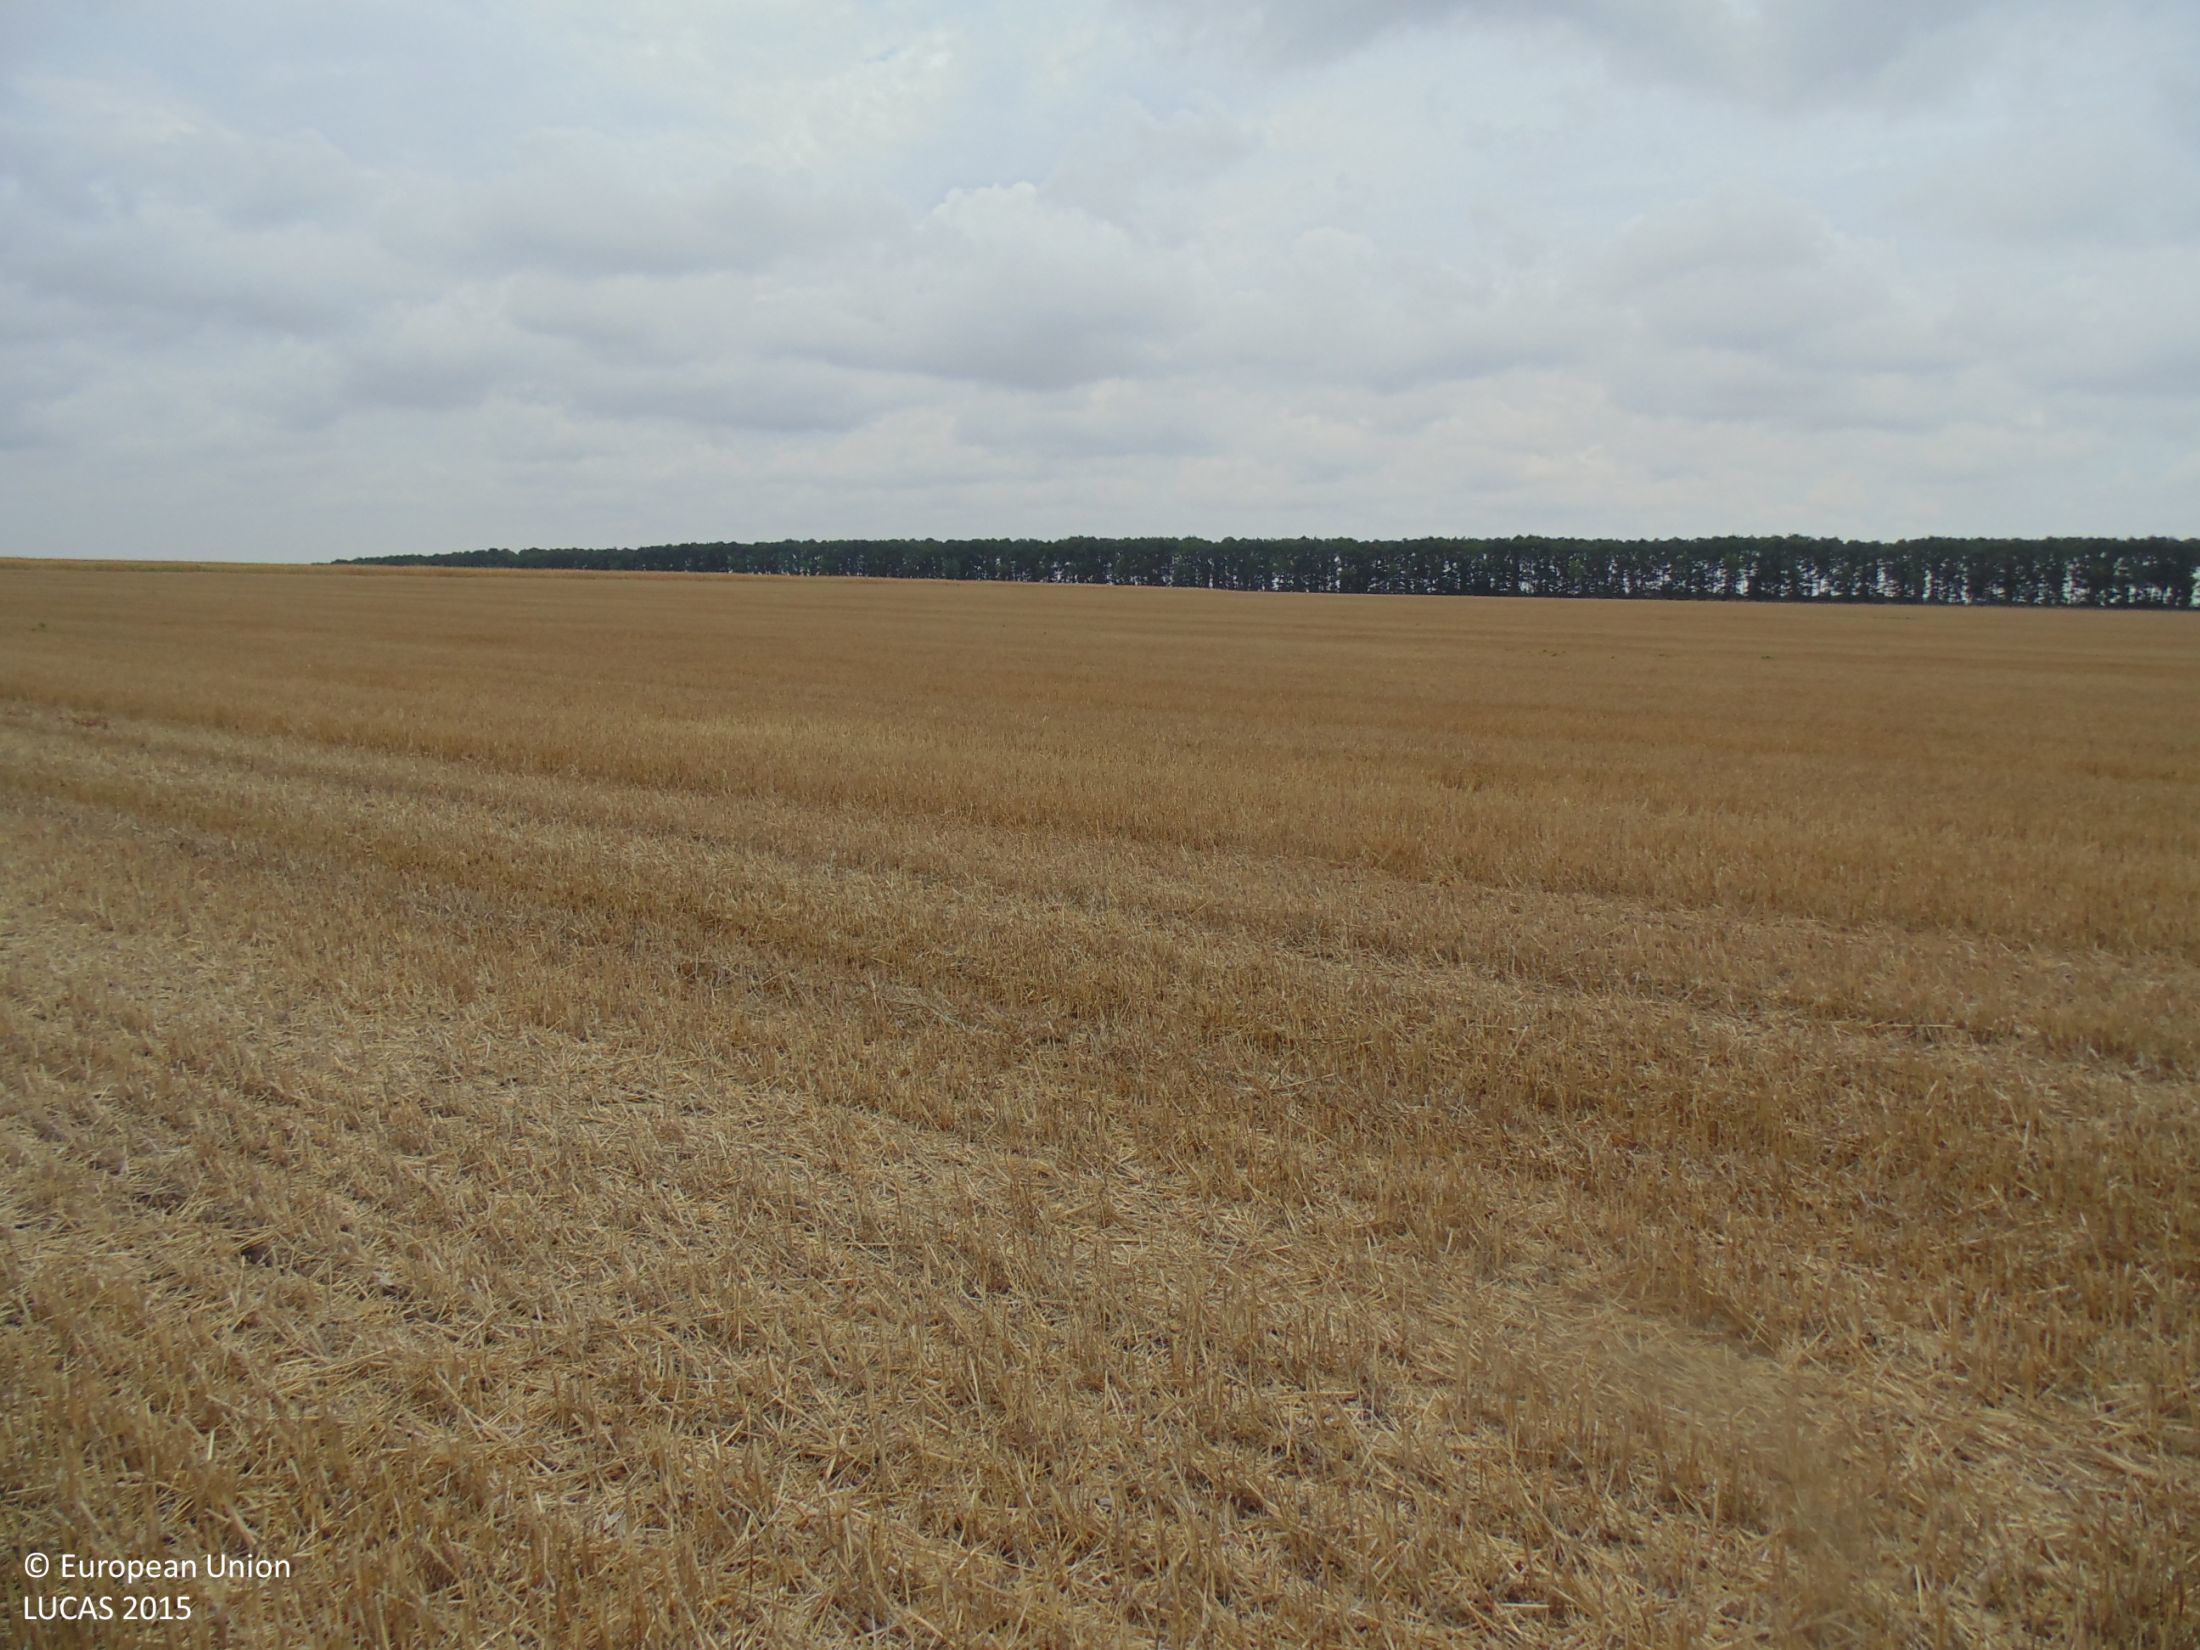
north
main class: Cropland
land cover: Common wheat
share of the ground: 25 - 50 %
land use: Agriculture (excluding fallow land and kitchen gardens)
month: August
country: BG
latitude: 43.5565
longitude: 28.4949
